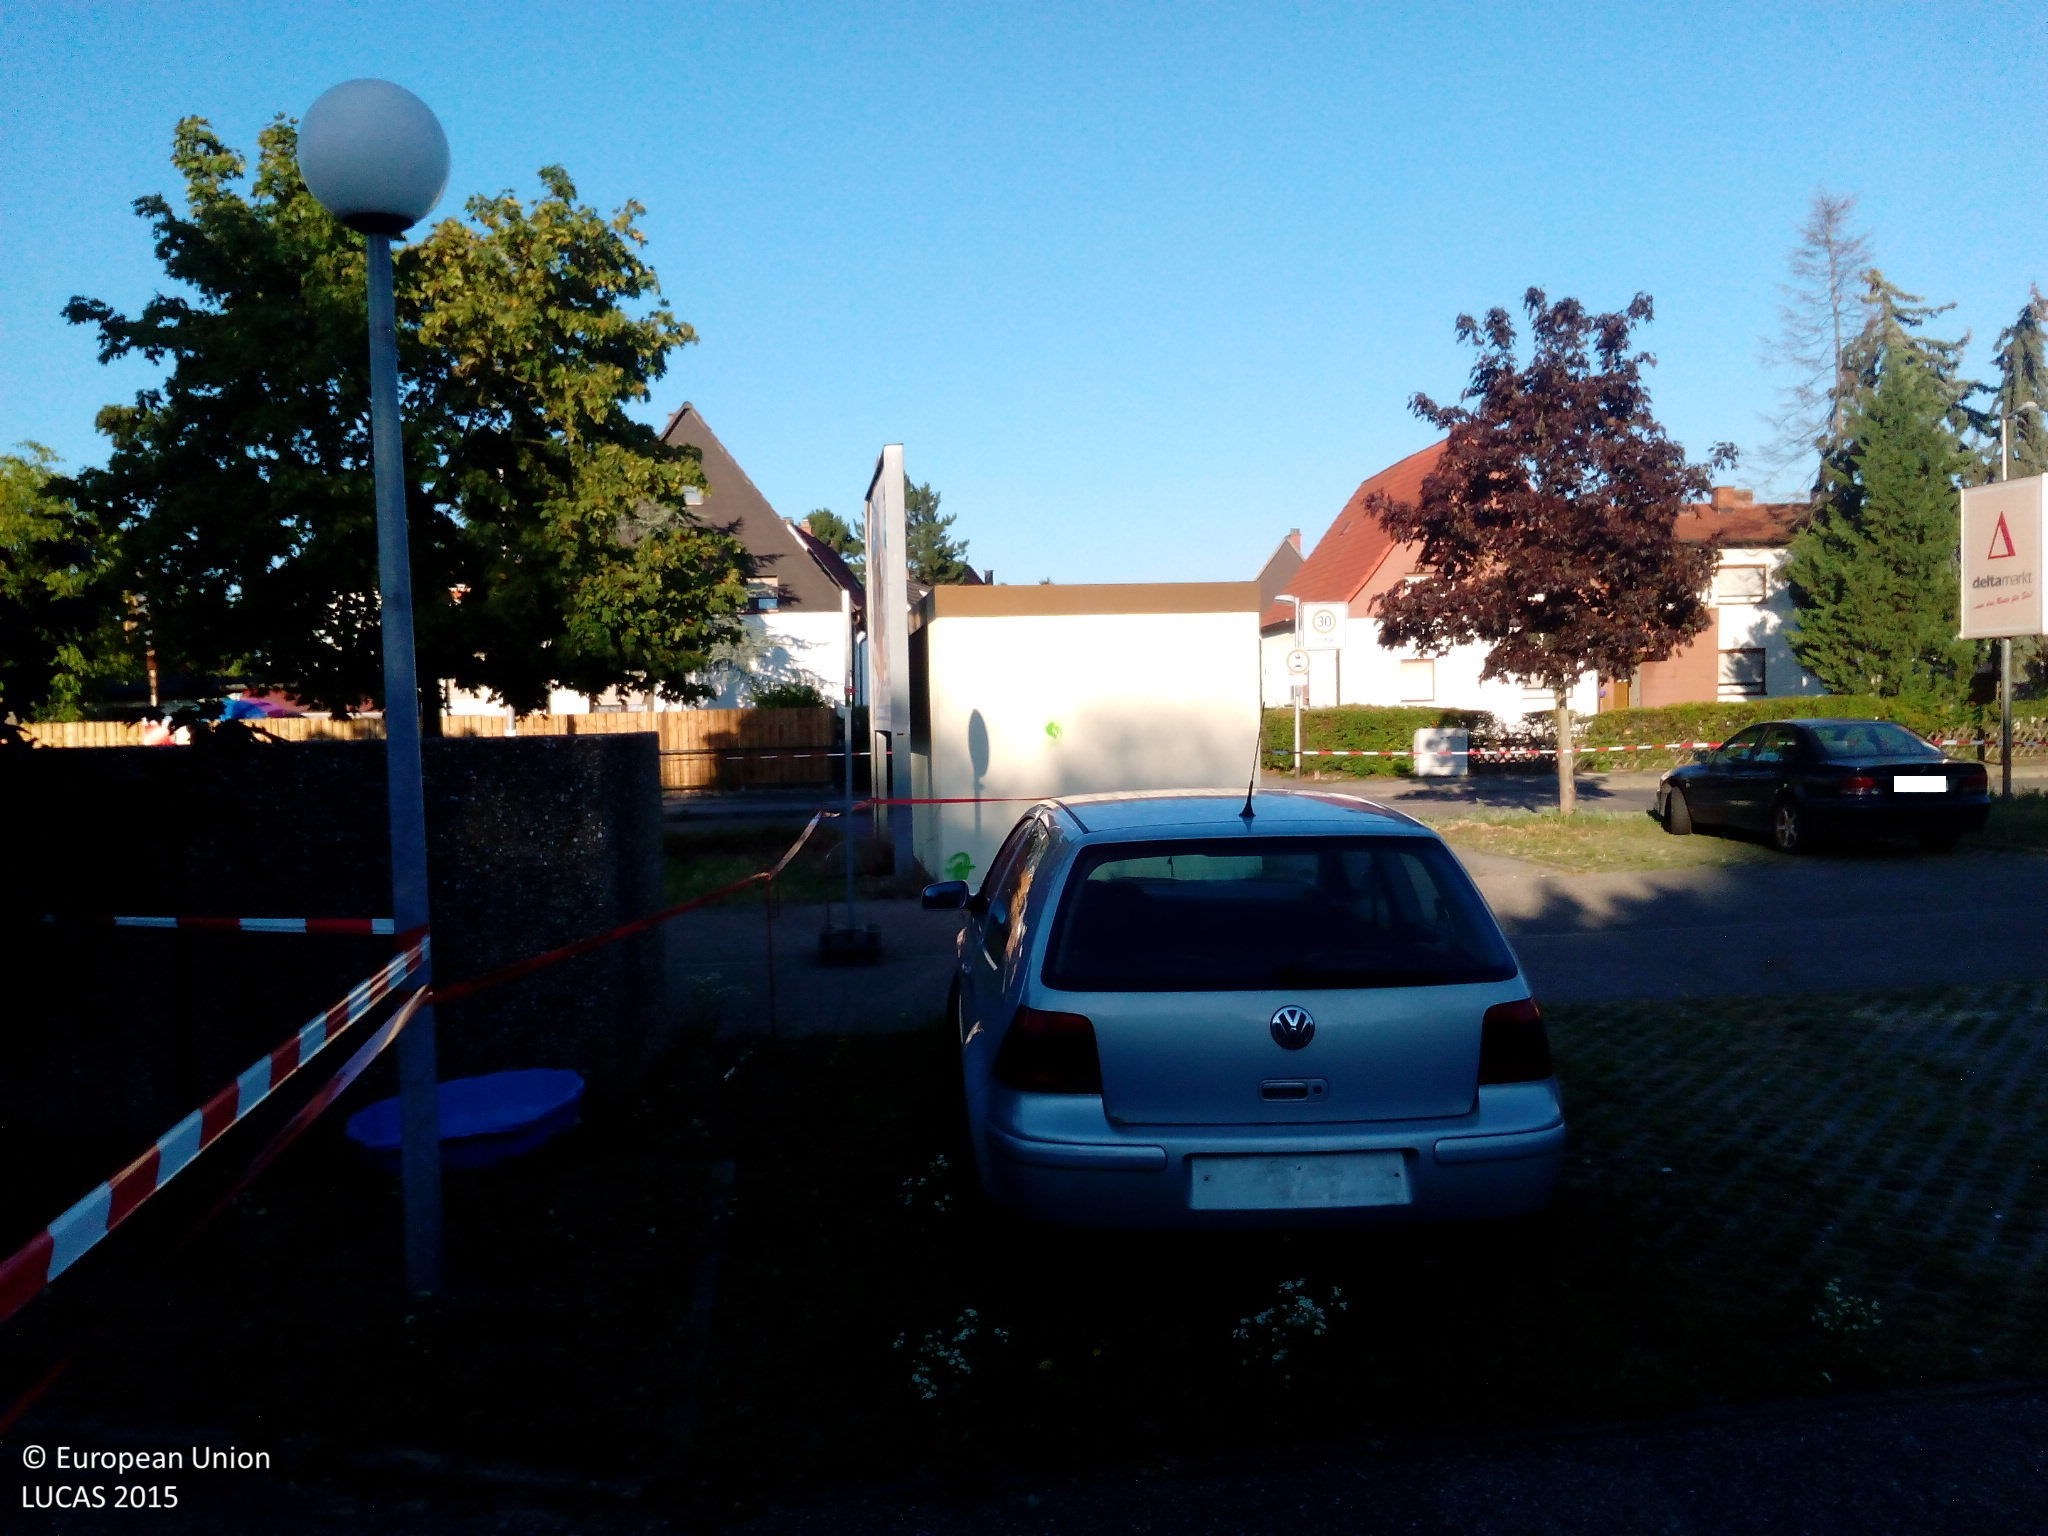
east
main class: Woodland
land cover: Broadleaved woodland
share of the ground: > 75 %
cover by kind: broadleaved forest trees 60 %, shrubs 20 %, herbaceous plants 20 %
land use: Semi-natural and natural areas not in use
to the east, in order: Broadleaved woodland; Artificial constructions in urban areas
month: August
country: DE
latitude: 49.4192
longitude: 8.5255
